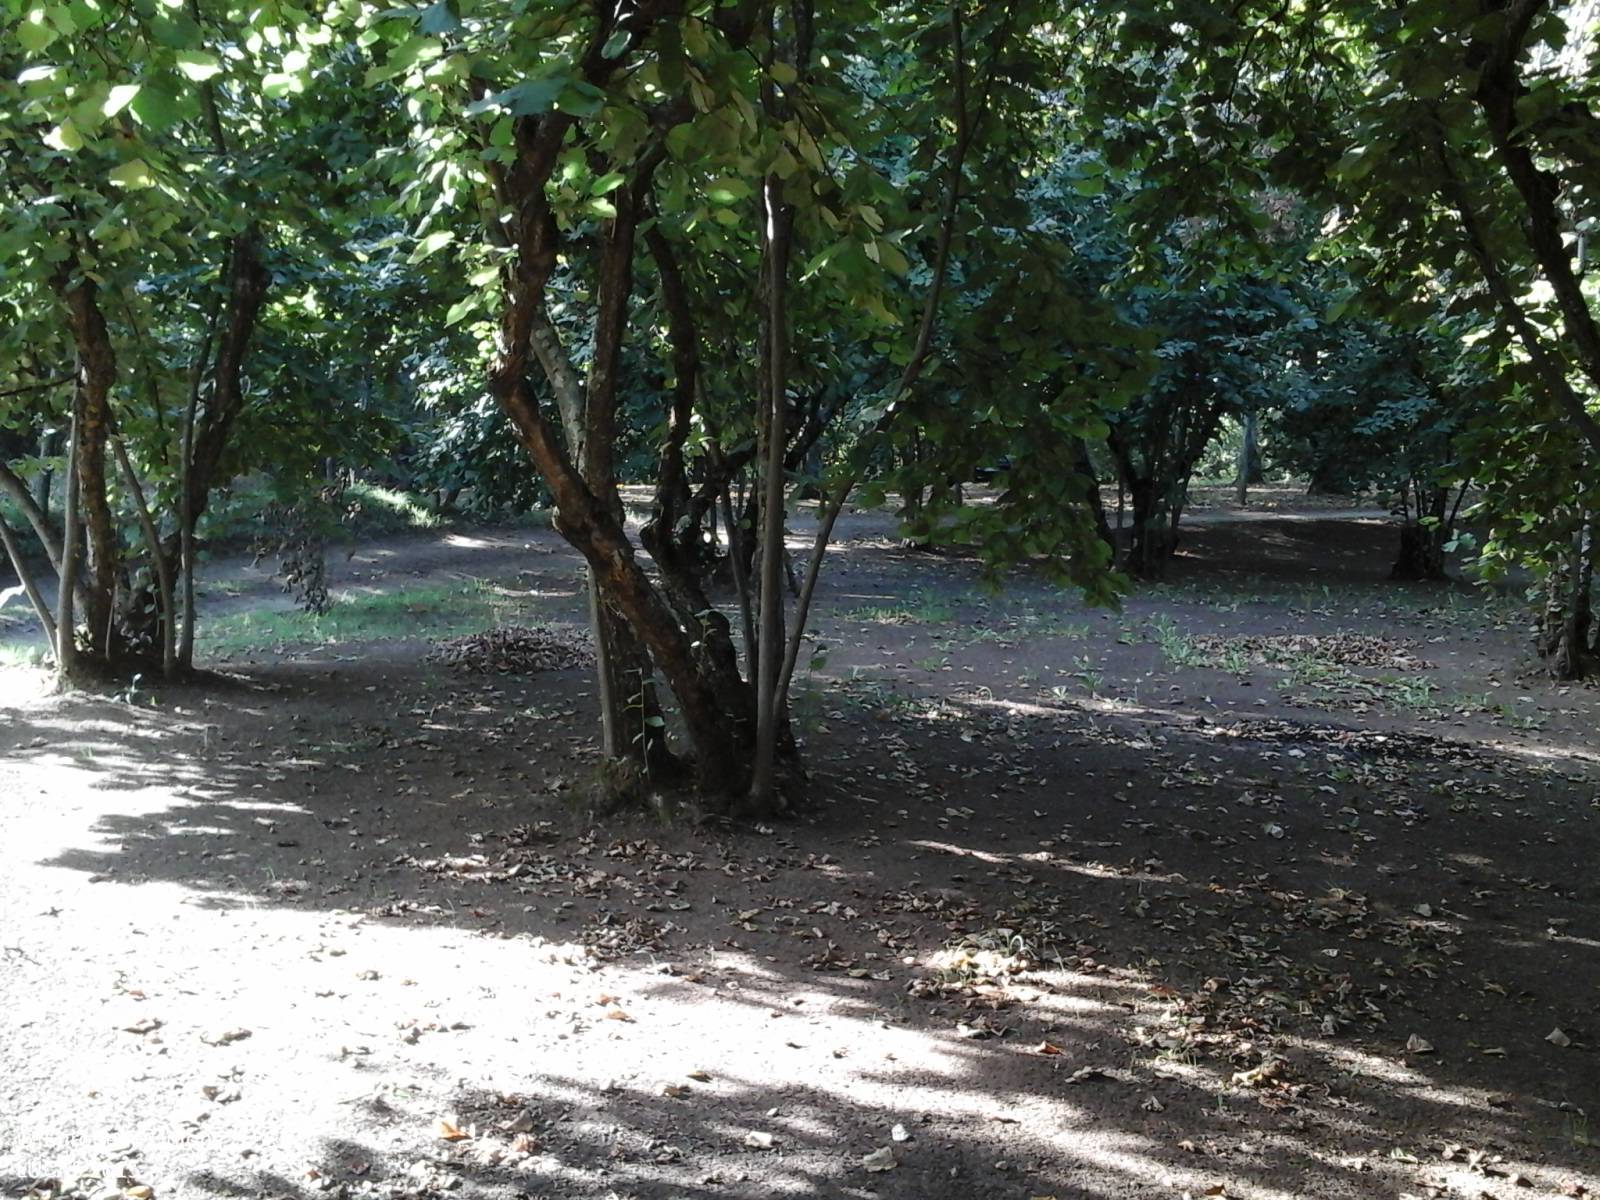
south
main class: Cropland
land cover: Nuts trees
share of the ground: > 75 %
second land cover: Grassland without tree/shrub cover
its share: > 75 %
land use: Agriculture (excluding fallow land and kitchen gardens)
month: September
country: IT
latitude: 42.3938
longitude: 12.2639
